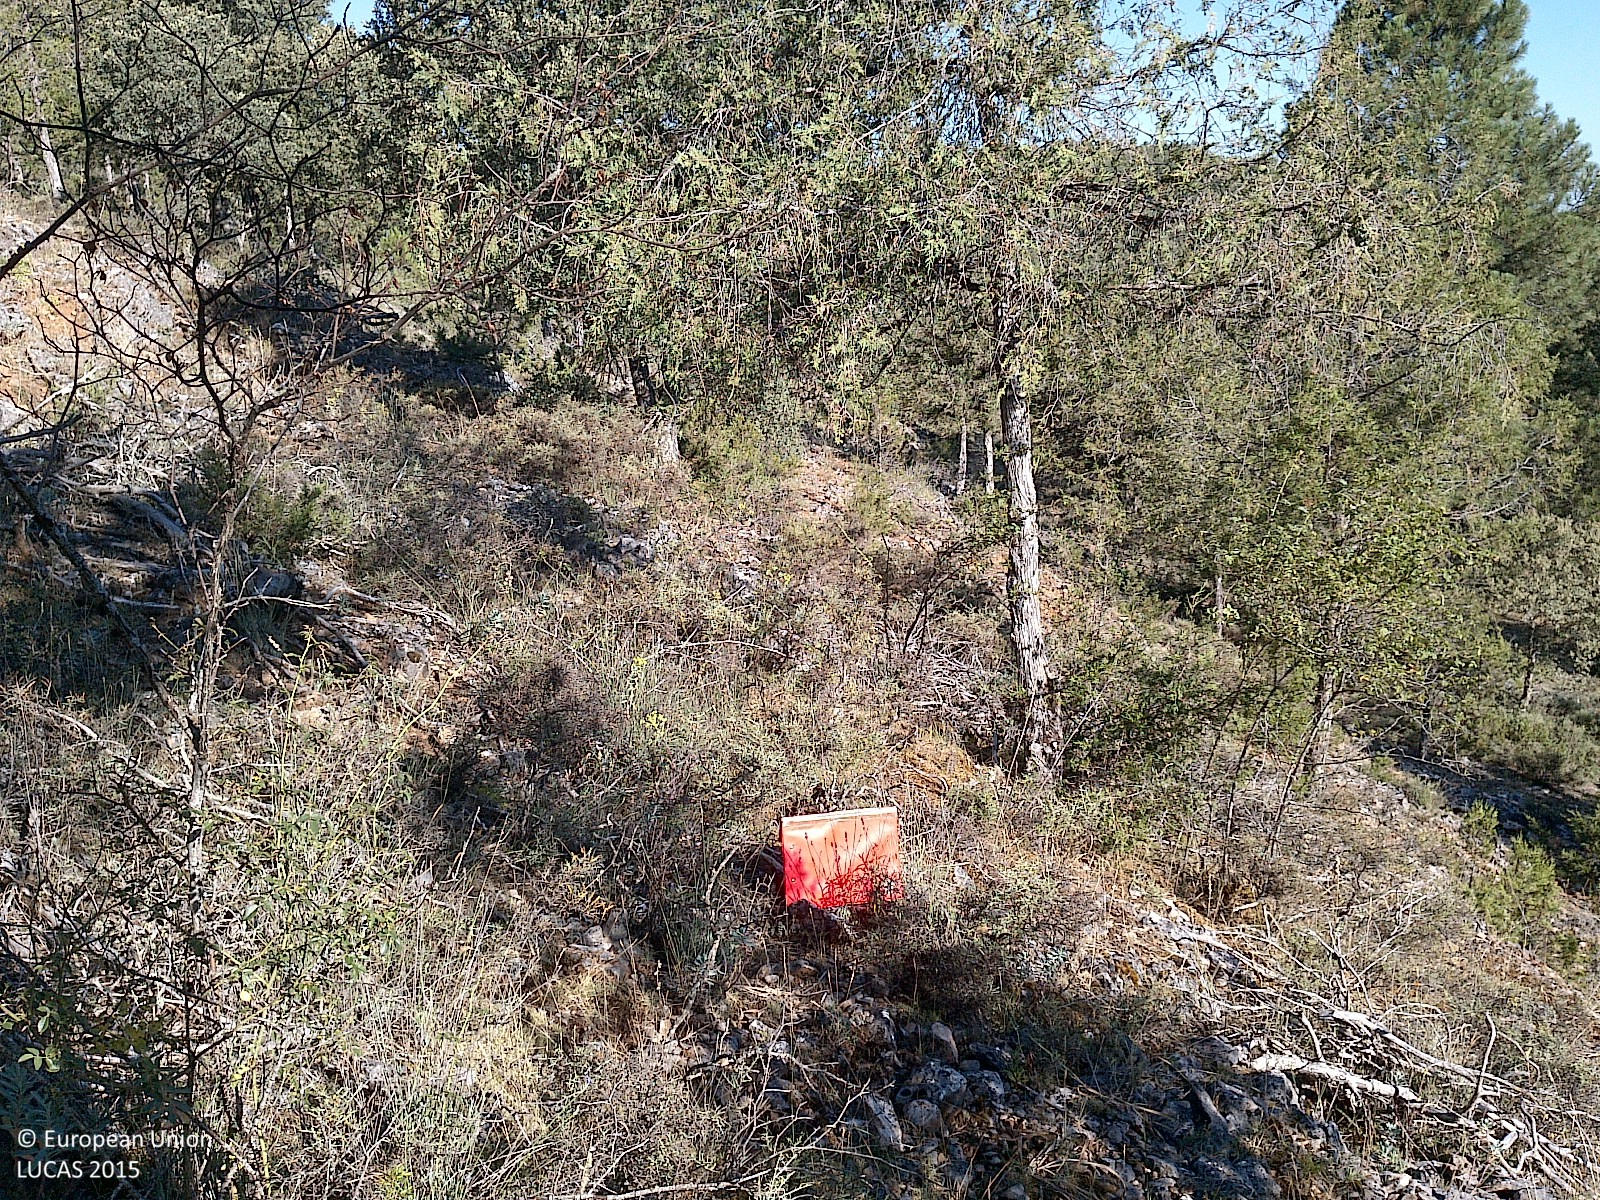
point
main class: Woodland
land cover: Other coniferous woodland
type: coniferous forest of the mediterranean region
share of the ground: 25 - 50 %
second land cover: Shrubland without tree cover
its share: 10 - 25 %
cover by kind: consolidated bare surface 30 %, coniferous forest trees 25 %, herbaceous plants 20 %, shrubs 15 %, broadleaved forest trees 5 %, unconsolidated bare surface 5 %
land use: Forestry
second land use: Agriculture (excluding fallow land and kitchen gardens)
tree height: < 5 m
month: July
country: ES
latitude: 41.8049
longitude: -3.0566
